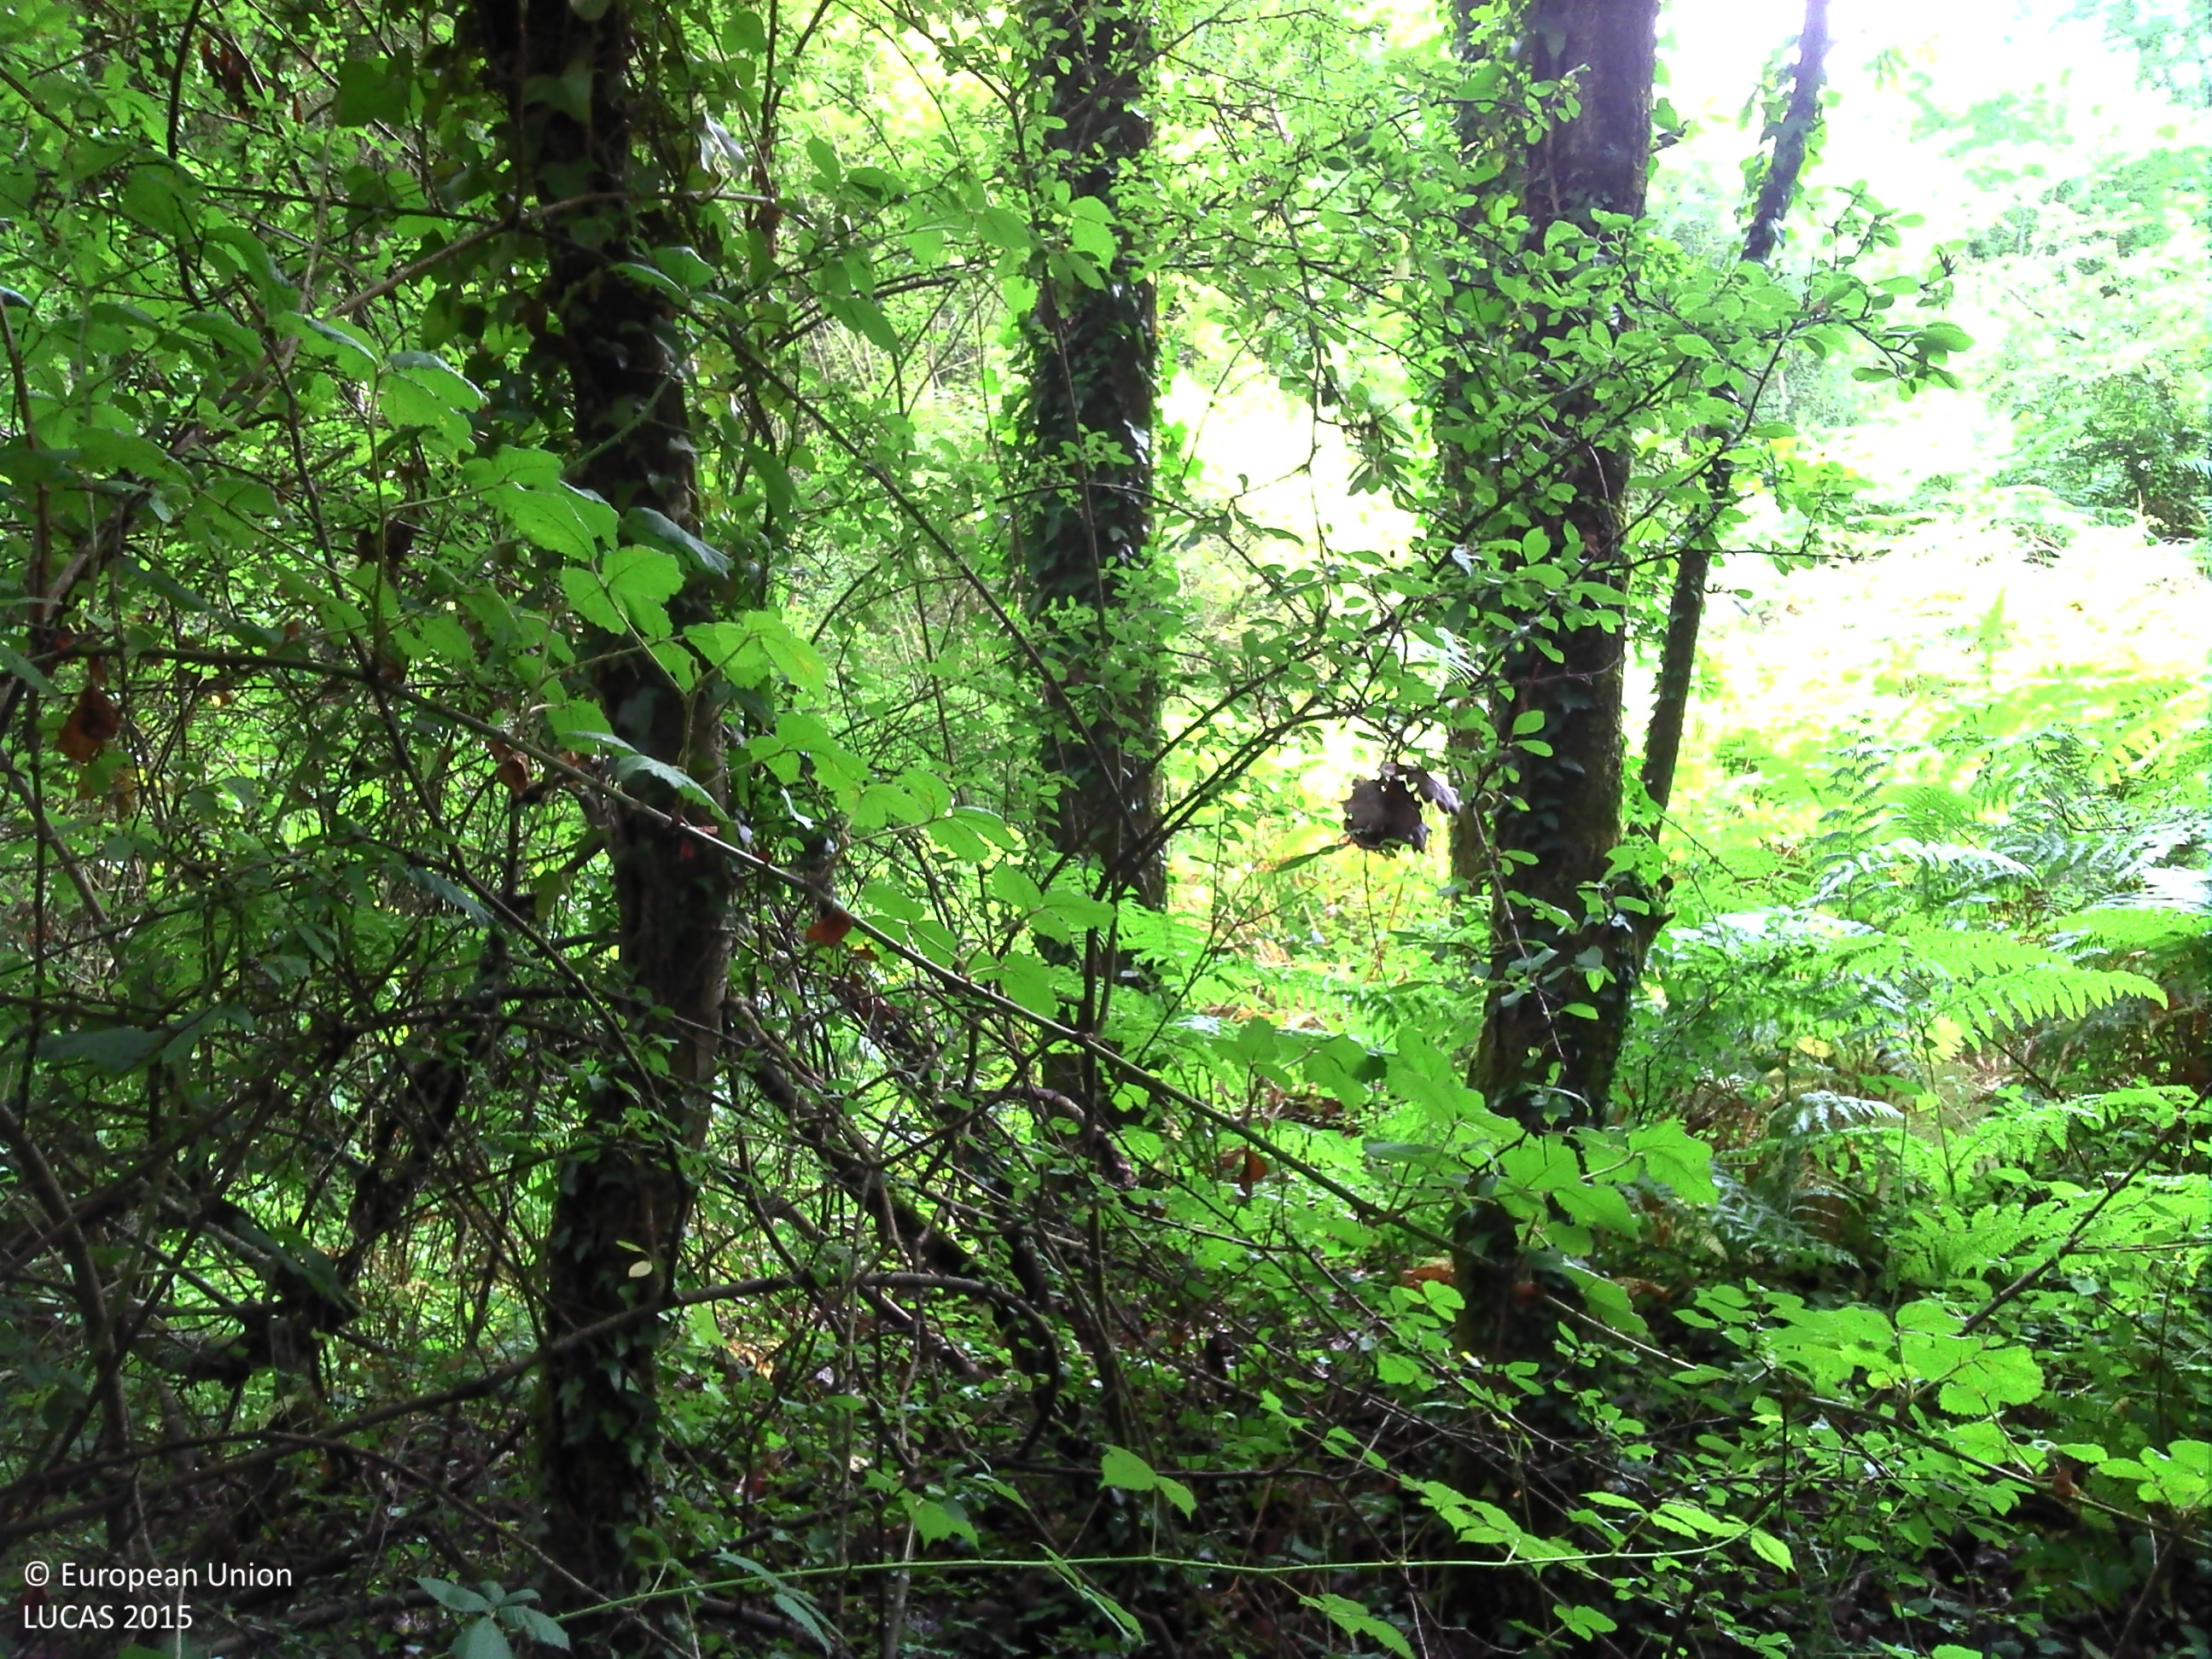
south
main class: Woodland
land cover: Broadleaved woodland
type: acidophilous oak and oak-birch forest
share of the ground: > 75 %
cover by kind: broadleaved forest trees 60 %, herbaceous plants 20 %, shrubs 10 %, consolidated bare surface 10 %
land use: Forestry
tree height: > 5 m
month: July
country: FR
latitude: 47.6593
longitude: -3.0764
